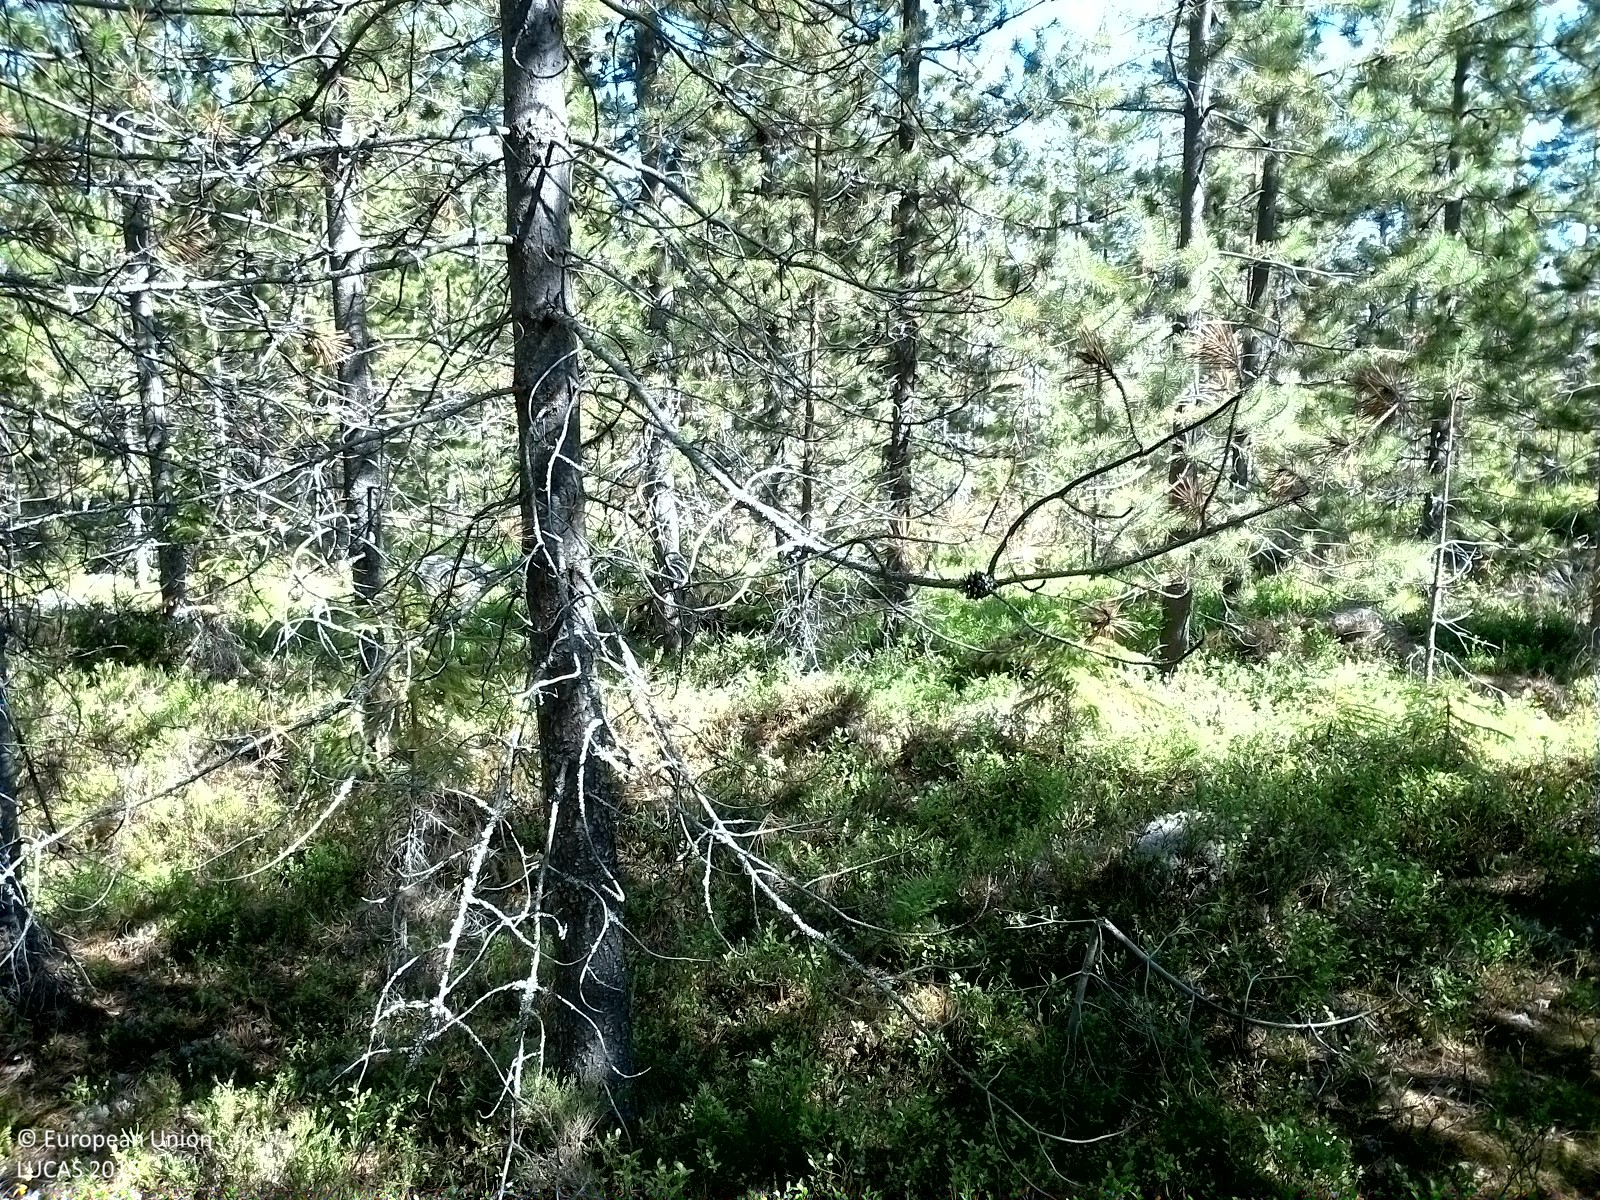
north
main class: Woodland
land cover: Pine dominated coniferous woodland
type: exotic forest
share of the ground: 25 - 50 %
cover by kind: shrubs 50 %, coniferous forest trees 40 %, broadleaved forest trees 5 %, lichens and mosses 5 %
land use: Forestry
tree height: > 5 m
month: July
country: SE
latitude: 62.2500
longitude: 17.0077
